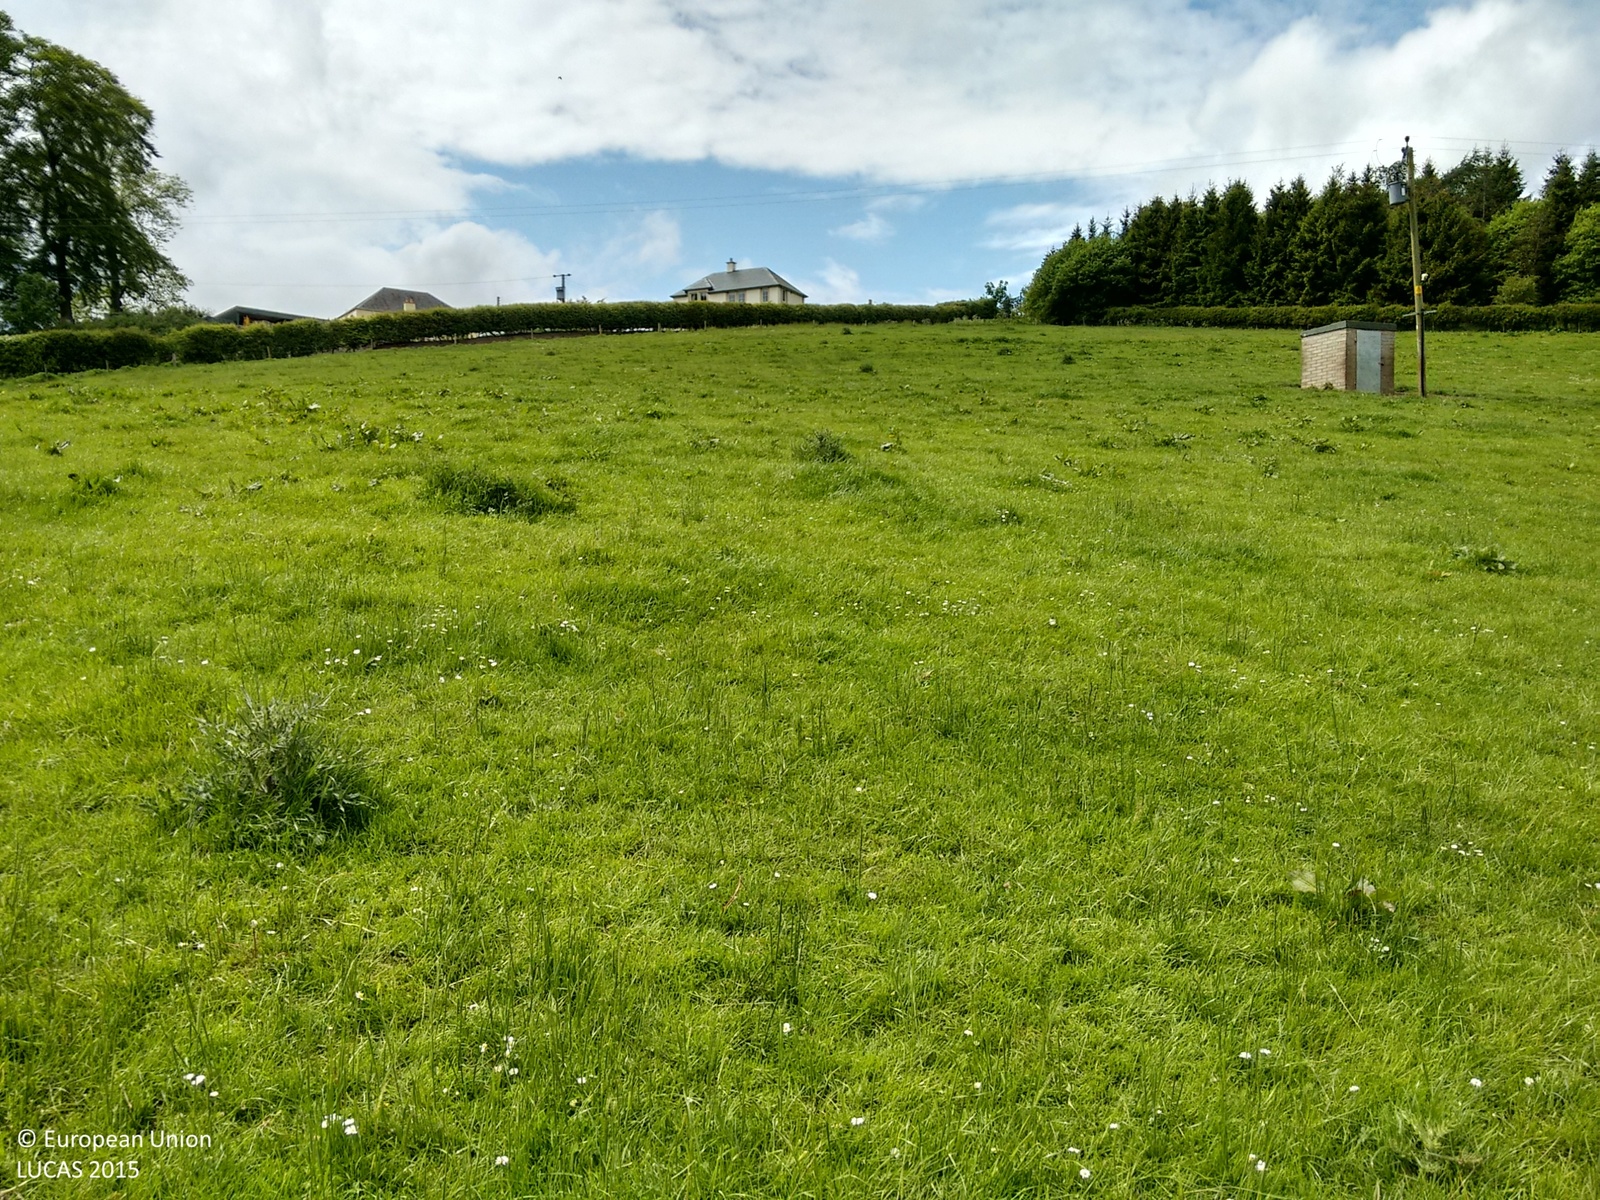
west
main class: Grassland
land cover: Grassland without tree/shrub cover
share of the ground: > 75 %
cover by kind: herbaceous plants 100 %
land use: Agriculture (excluding fallow land and kitchen gardens)
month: June
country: GB
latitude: 56.2939
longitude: -3.3054
